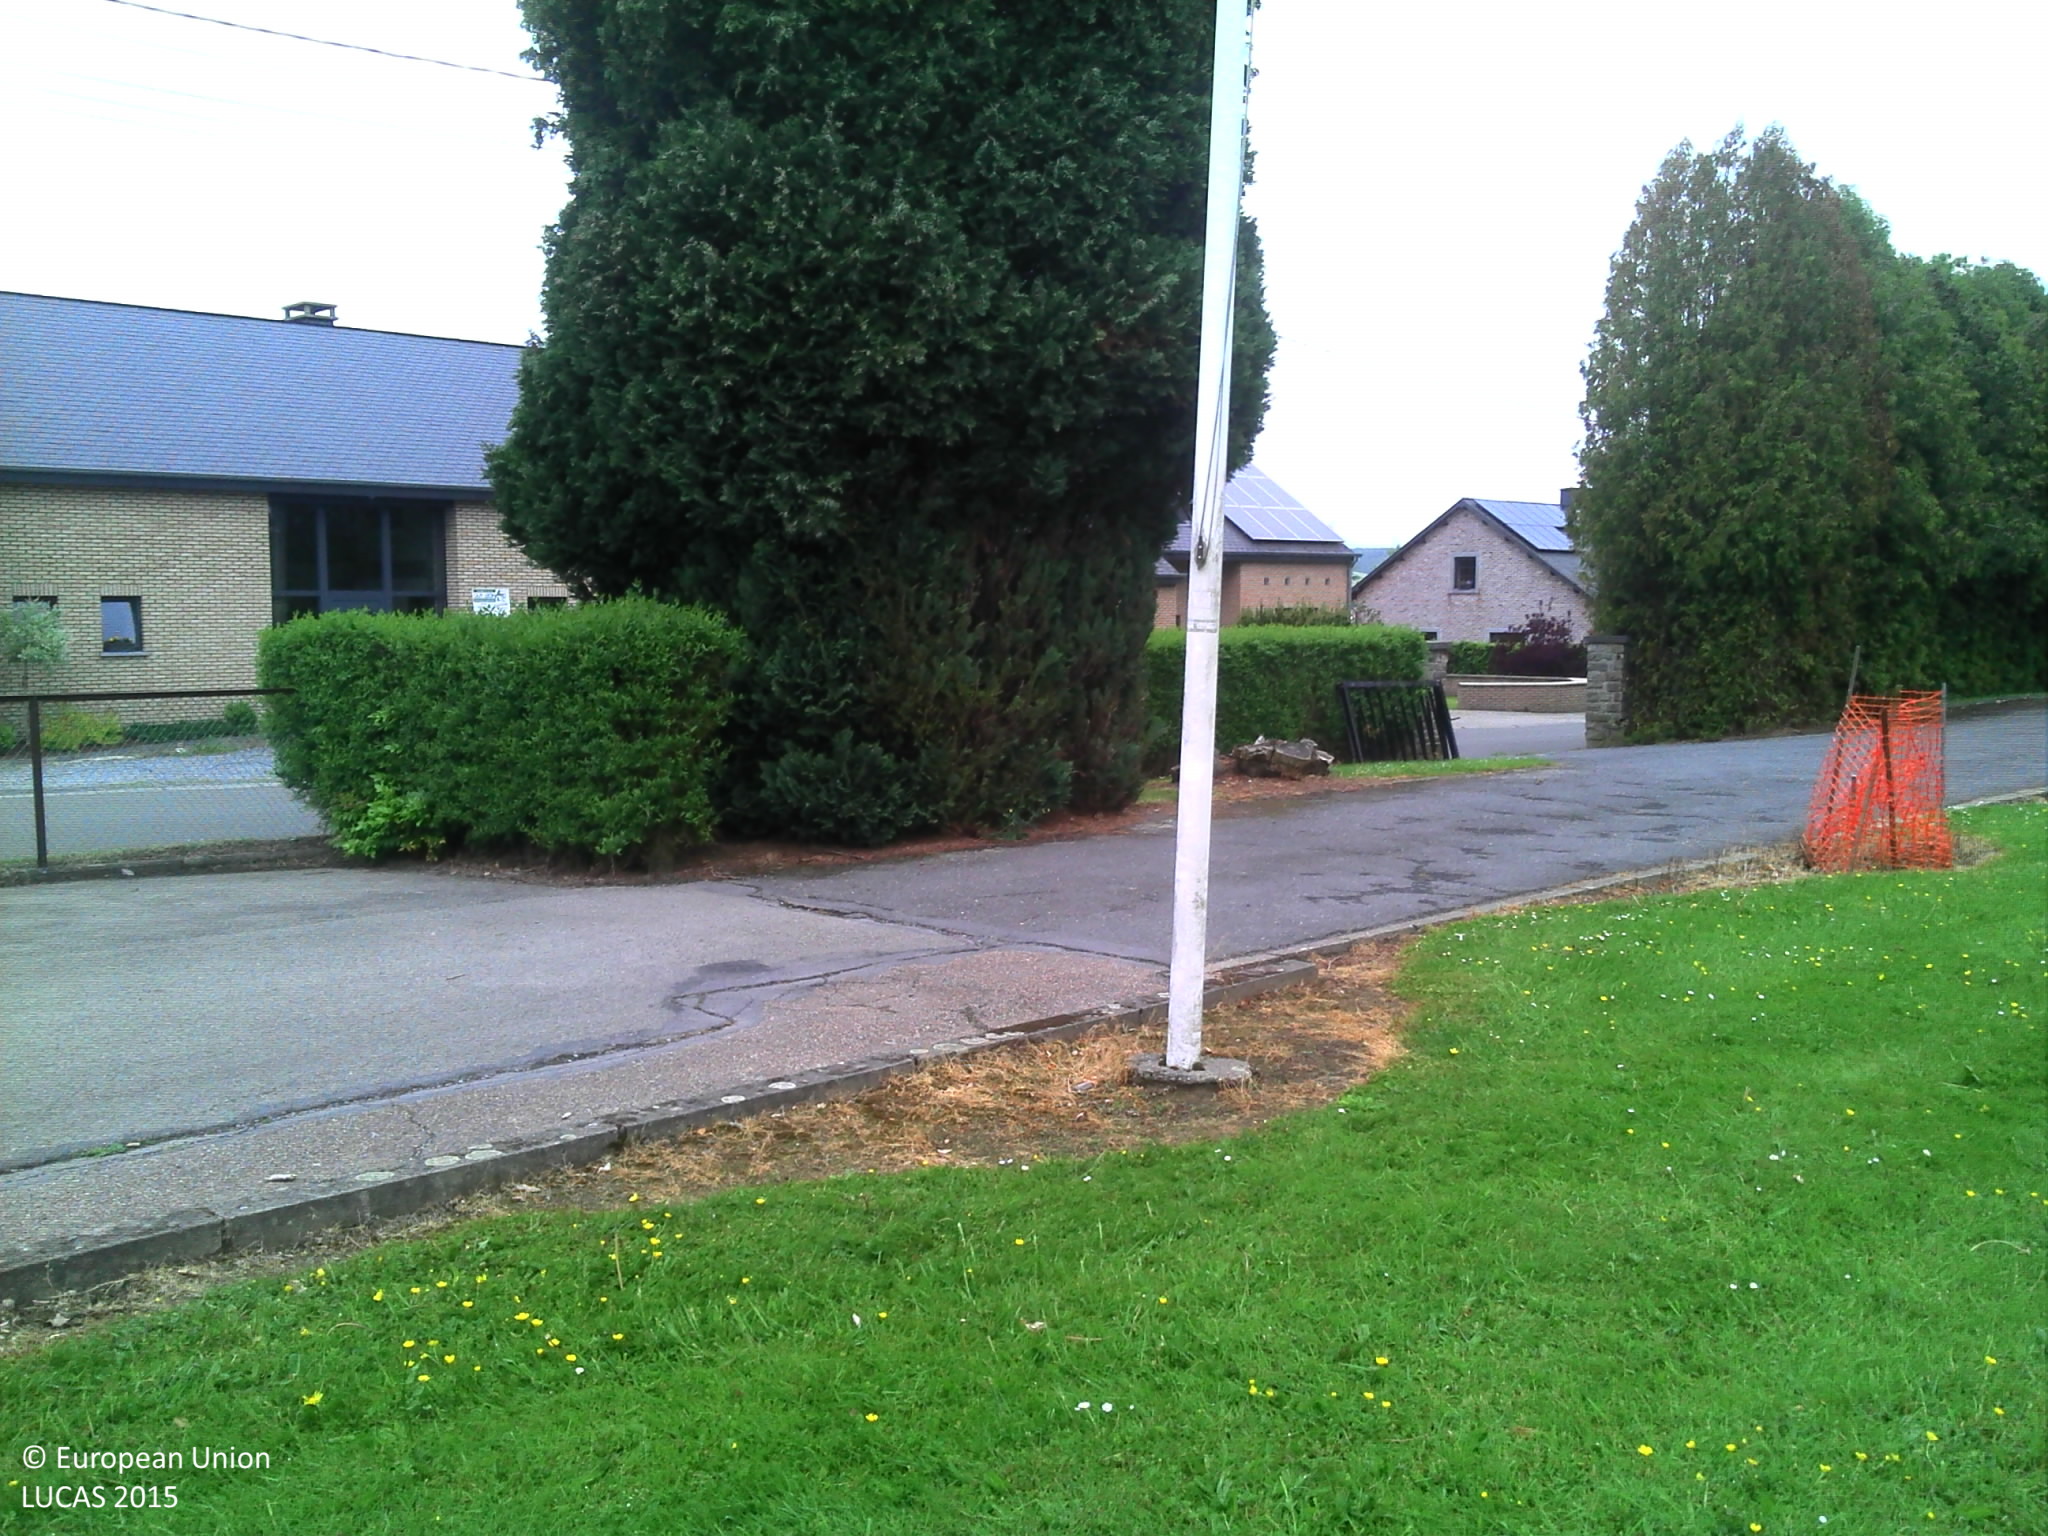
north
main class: Grassland
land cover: Grassland without tree/shrub cover
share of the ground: > 75 %
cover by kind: herbaceous plants 100 %
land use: Community services
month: June
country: BE
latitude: 50.2871
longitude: 5.8023
